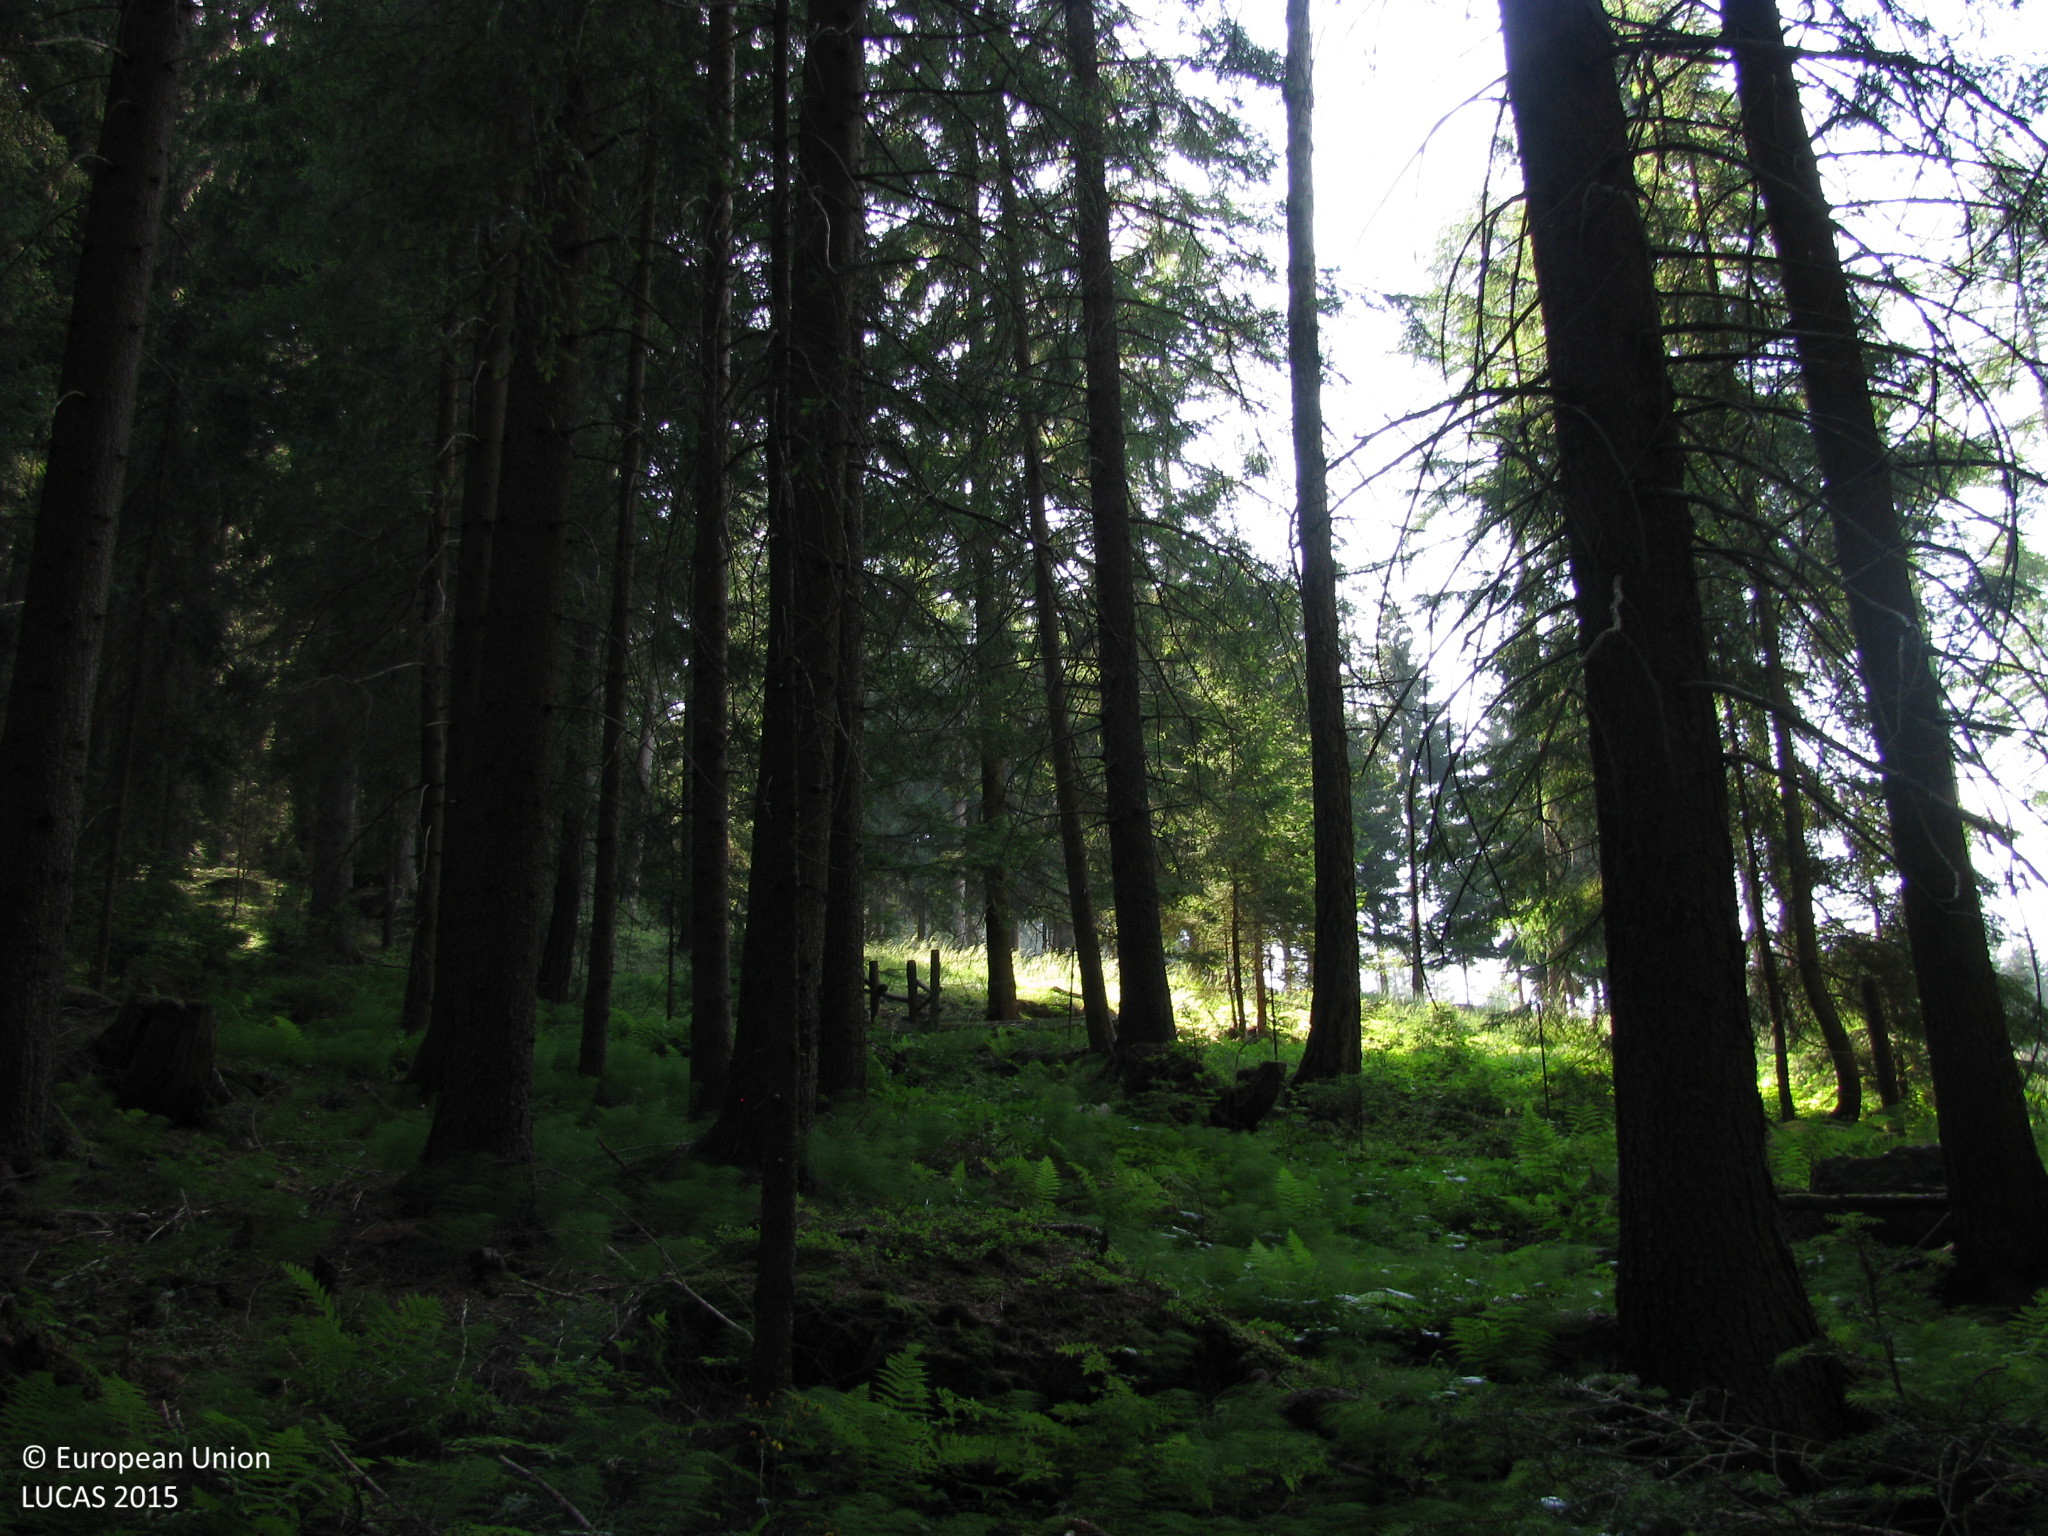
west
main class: Woodland
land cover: Spruce dominated coniferous woodland
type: alpine coniferous forest
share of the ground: > 75 %
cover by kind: coniferous forest trees 90 %, herbaceous plants 5 %, lichens and mosses 5 %
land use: Forestry
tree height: > 5 m
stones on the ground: < 10 %
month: July
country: AT
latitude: 47.0765
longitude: 14.7267
